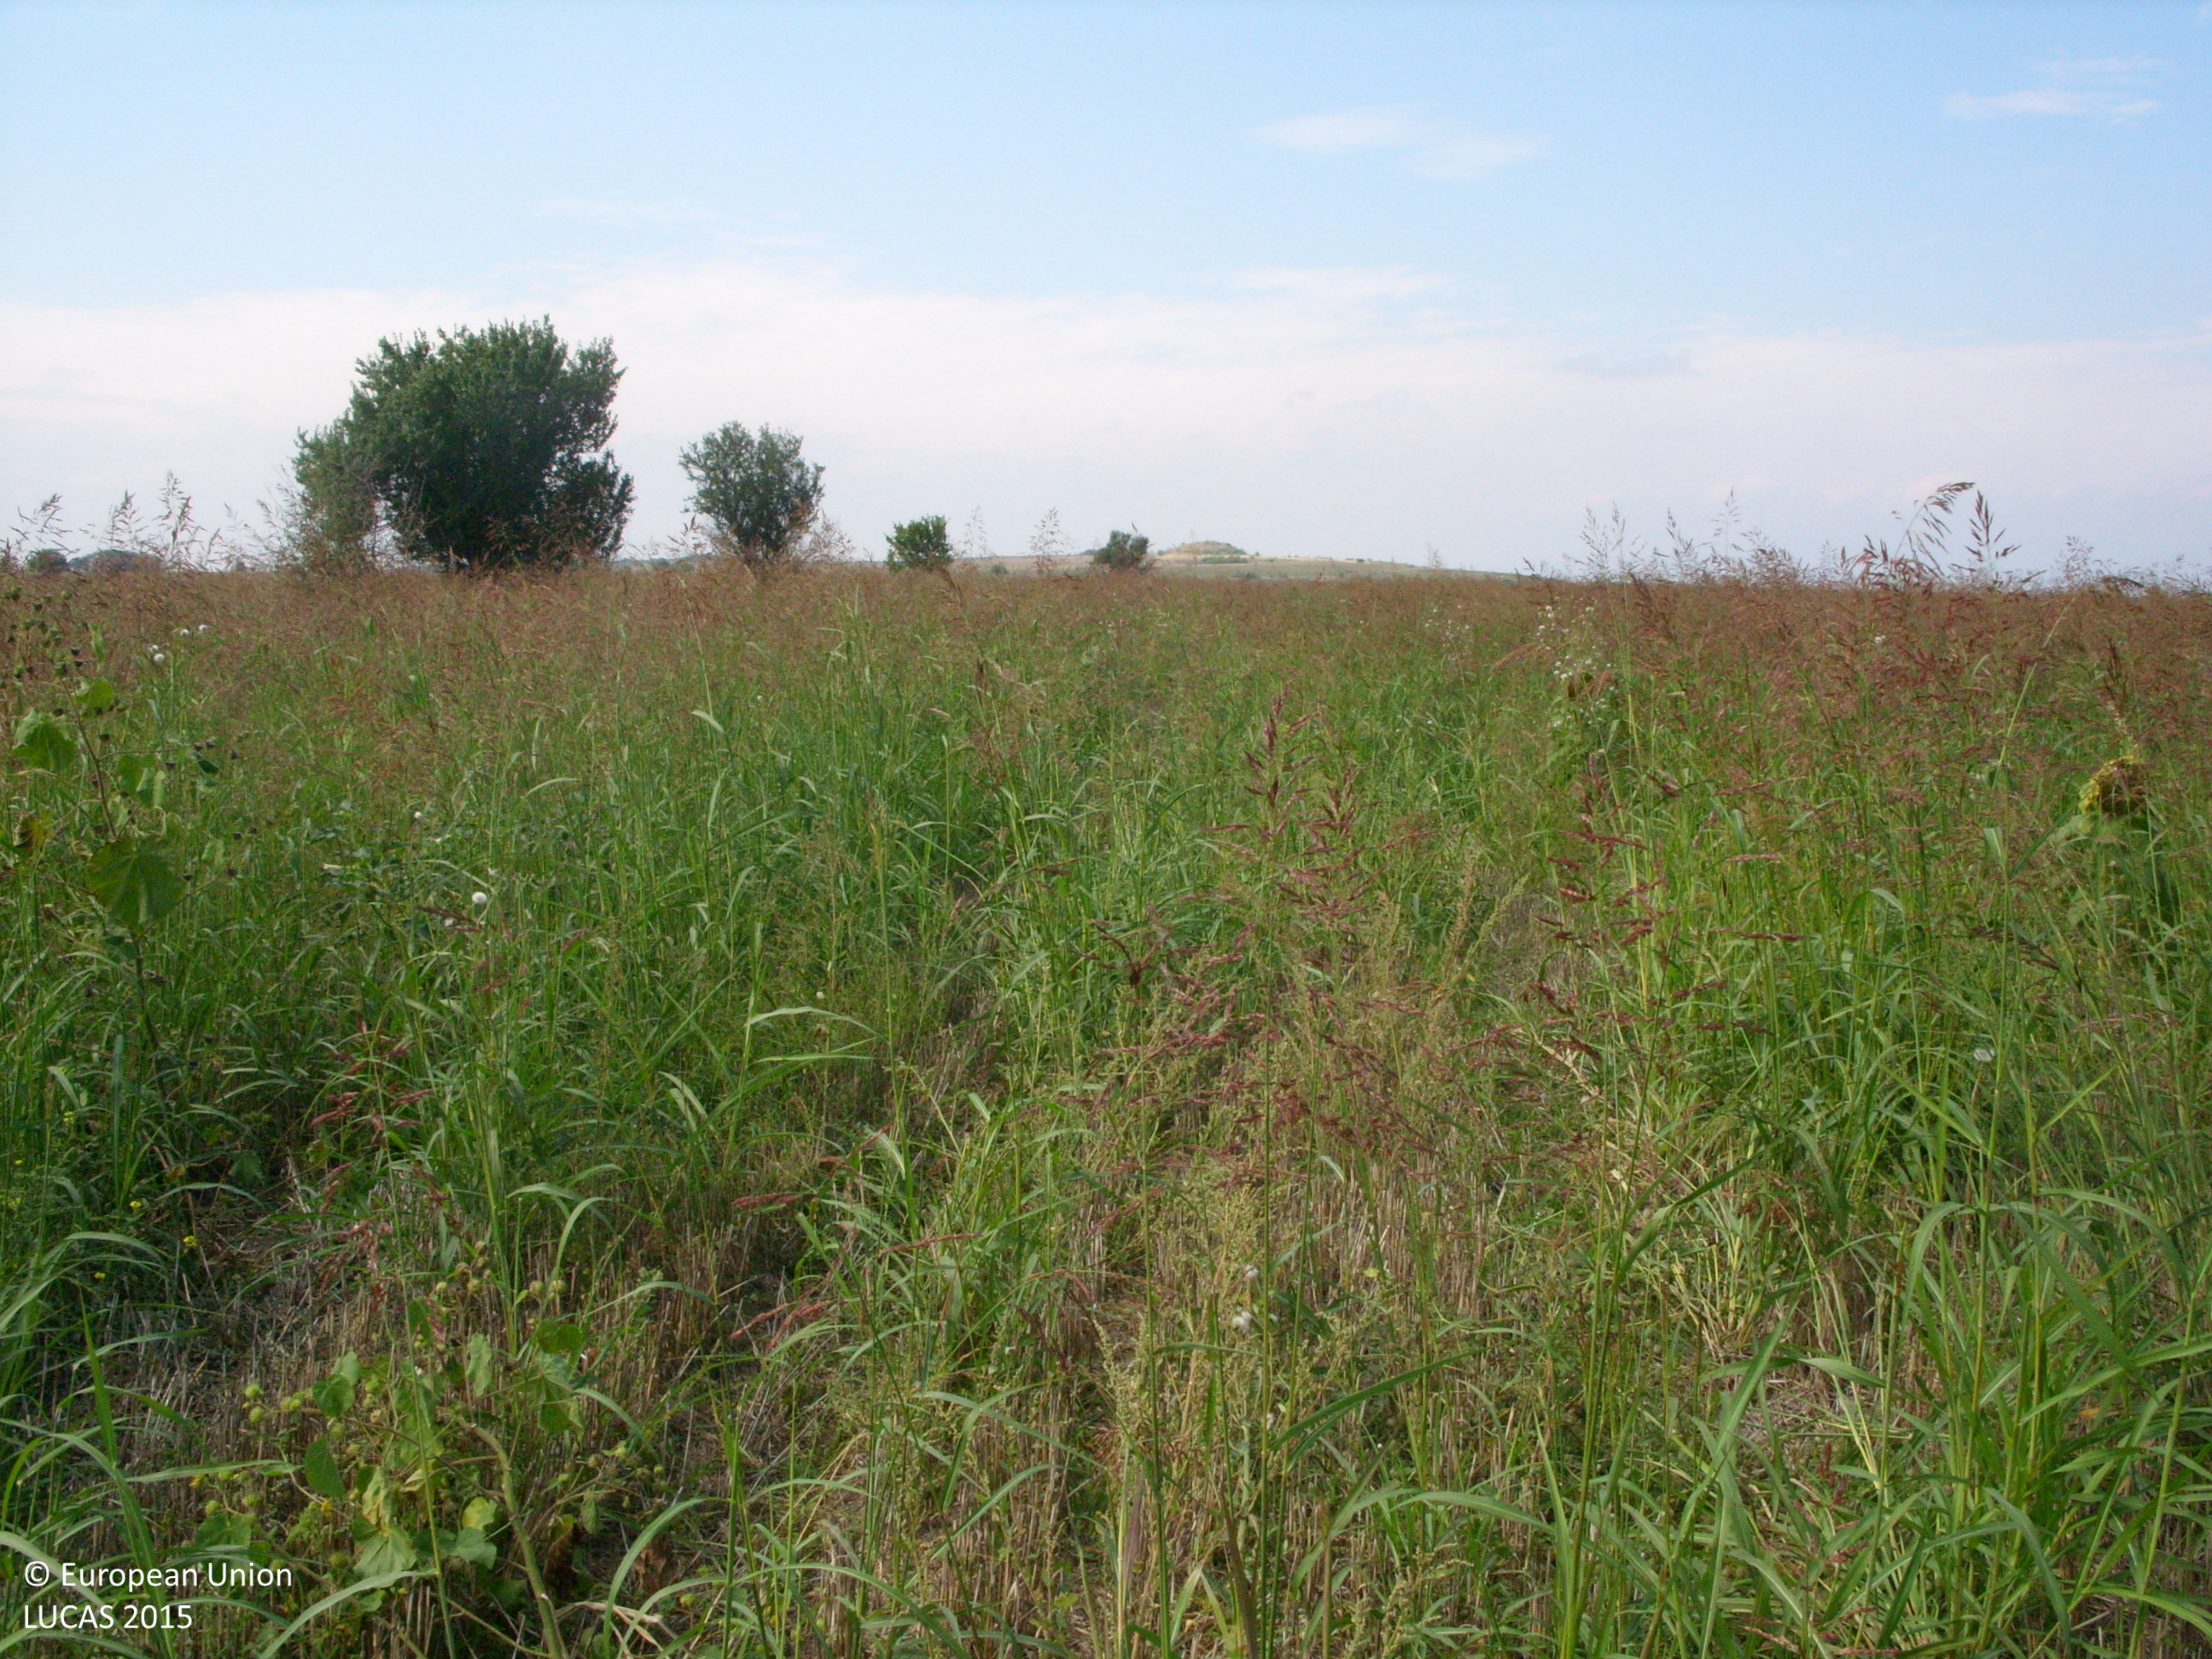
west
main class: Grassland
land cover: Spontaneously vegetated surfaces
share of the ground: > 75 %
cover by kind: herbaceous plants 100 %
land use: Fallow land
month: September
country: BG
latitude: 42.3899
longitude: 24.7648
